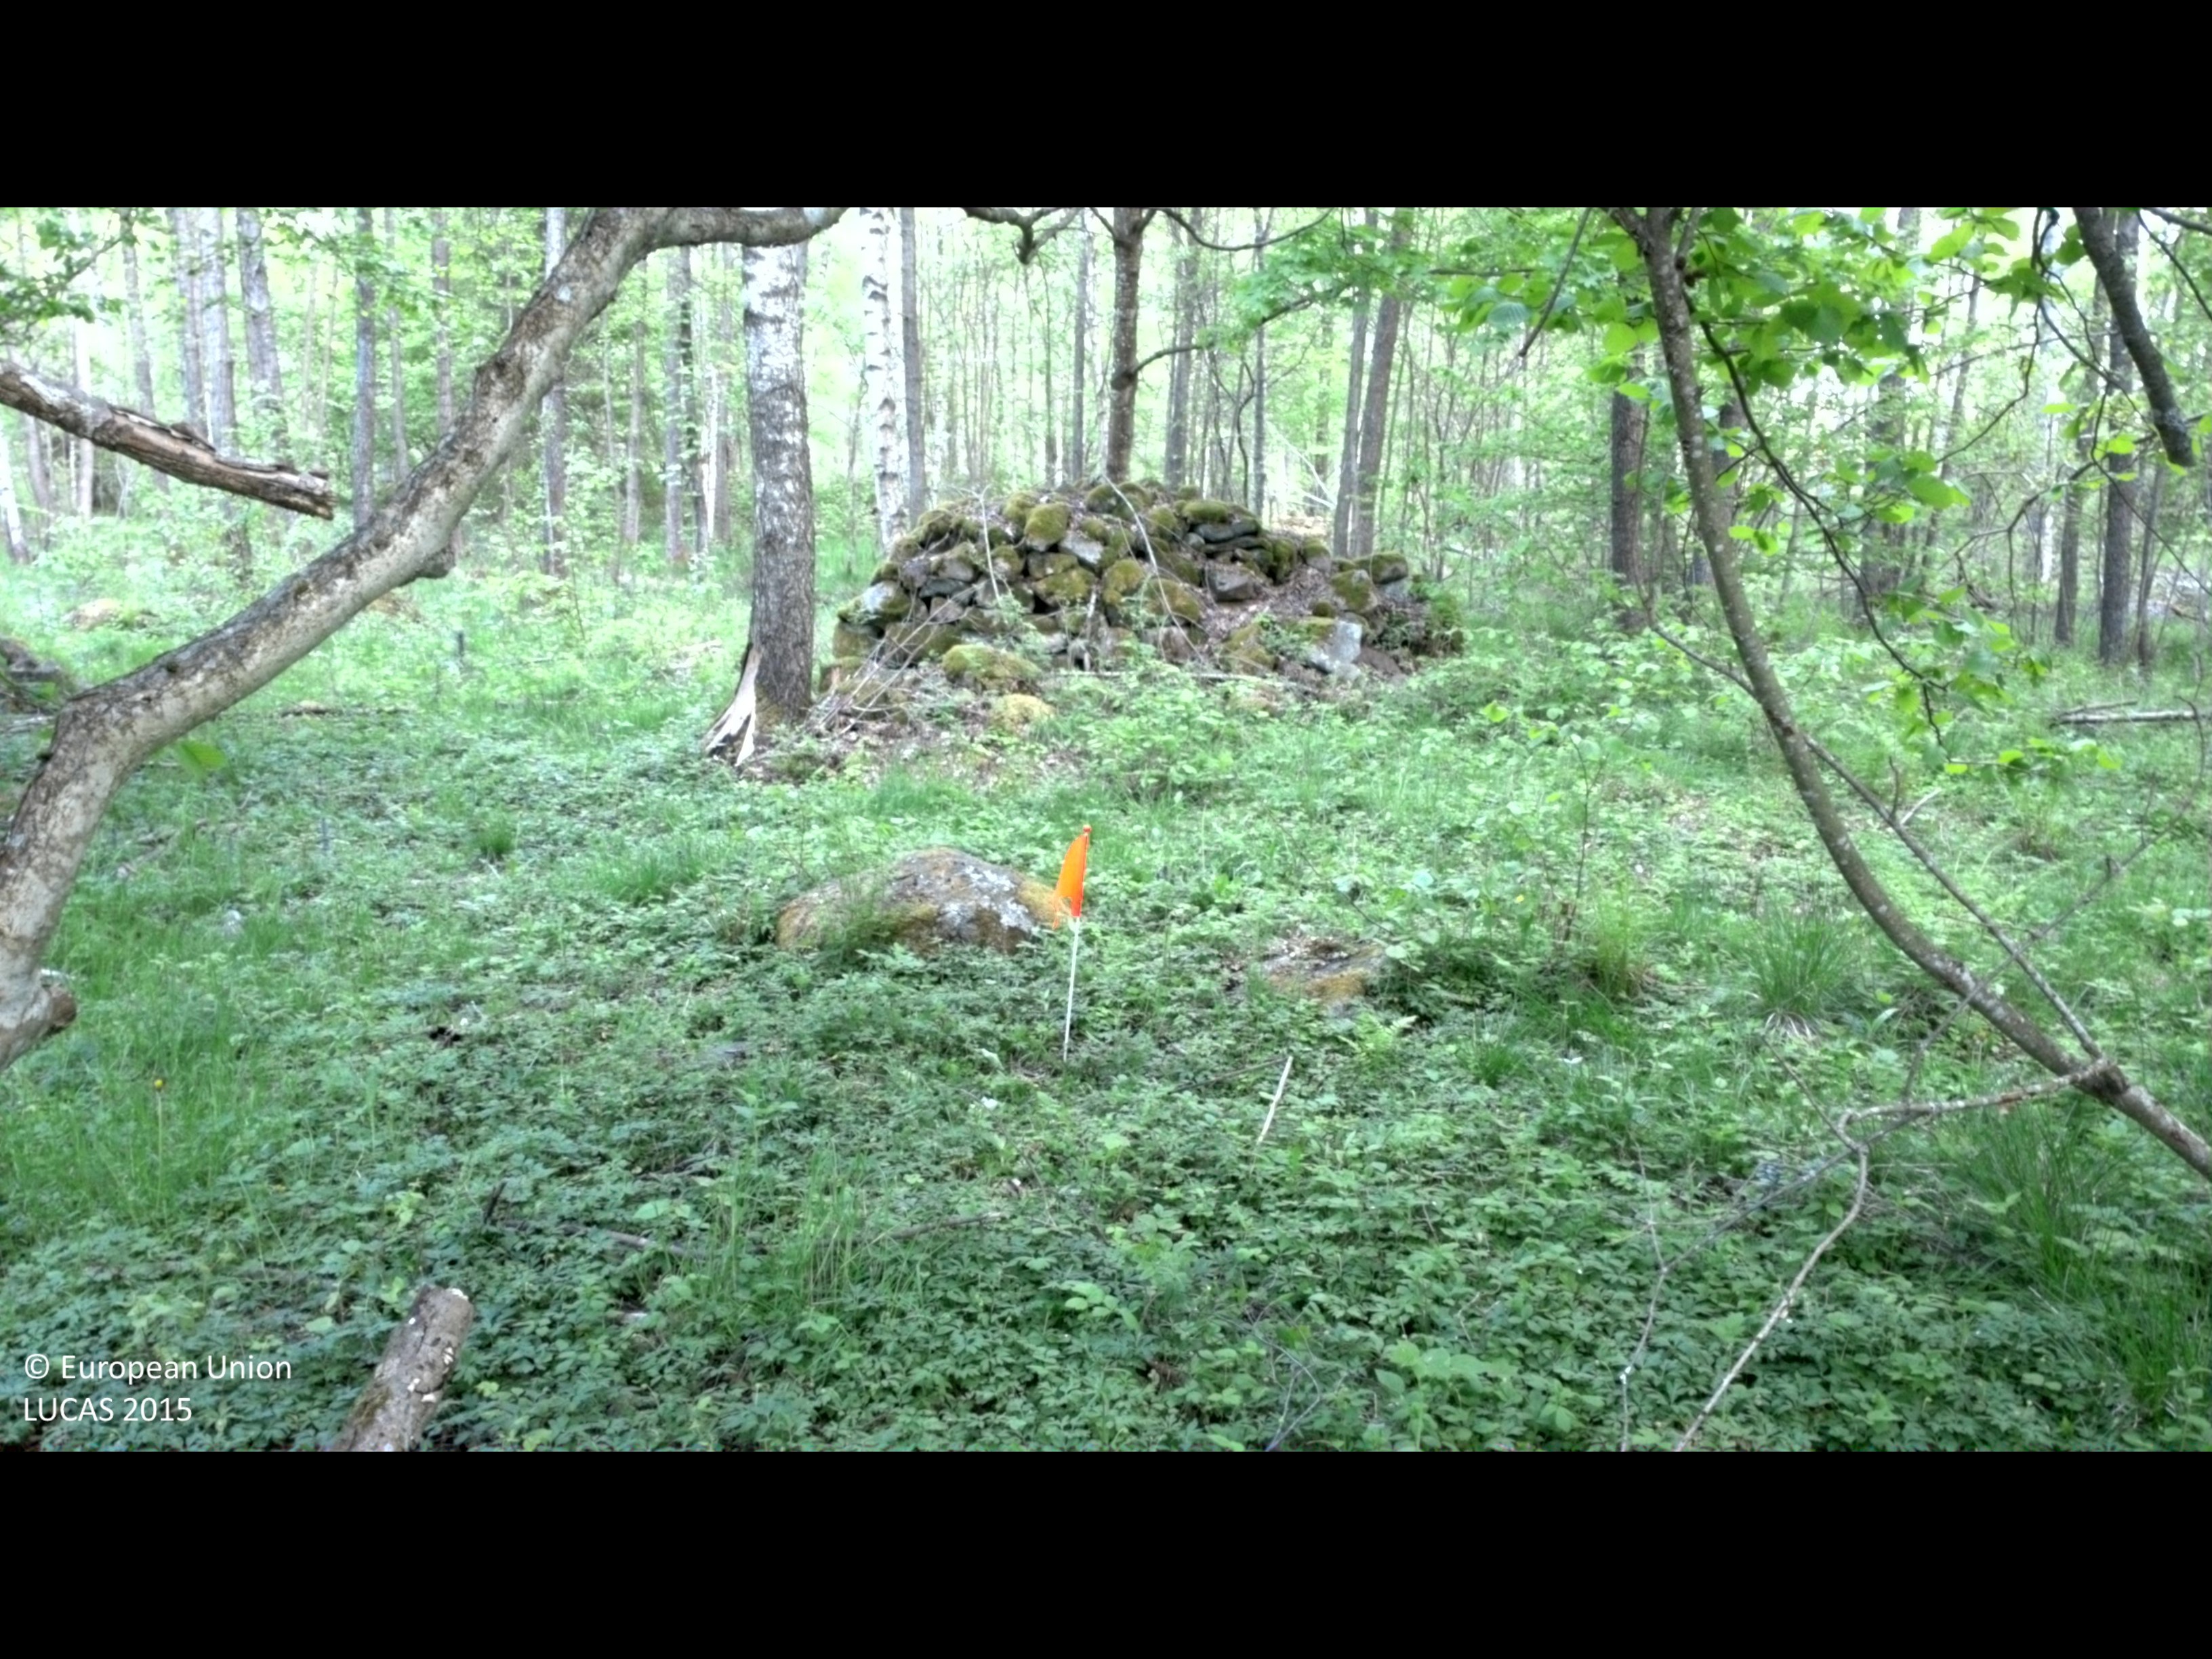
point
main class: Woodland
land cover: Broadleaved woodland
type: non-riverine alder, birch or aspen forest
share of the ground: 25 - 50 %
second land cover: Grassland without tree/shrub cover
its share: 50 - 75 %
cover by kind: herbaceous plants 50 %, broadleaved forest trees 45 %, shrubs 5 %
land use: Forestry
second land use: Agriculture (excluding fallow land and kitchen gardens)
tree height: > 5 m
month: May
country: SE
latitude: 57.3579
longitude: 16.1323
